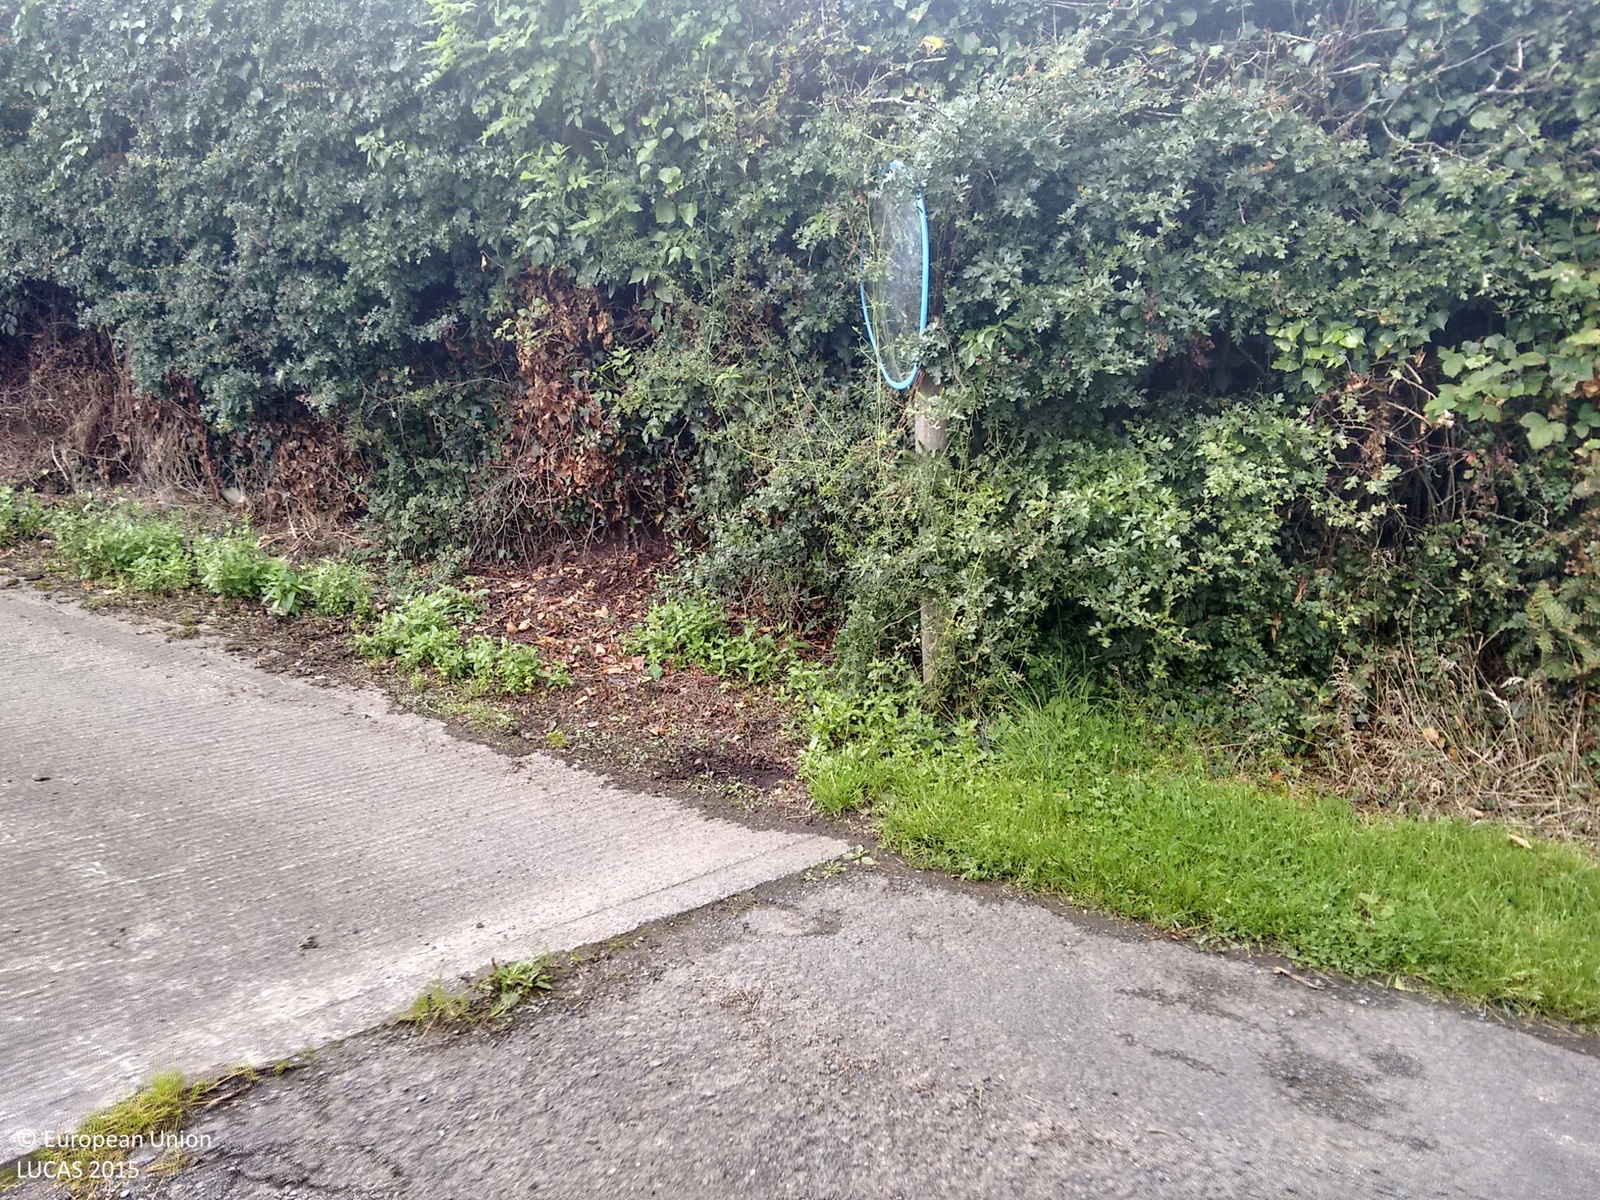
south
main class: Grassland
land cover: Grassland without tree/shrub cover
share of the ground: > 75 %
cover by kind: herbaceous plants 100 %
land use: Agriculture (excluding fallow land and kitchen gardens)
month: August
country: GB
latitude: 54.2849
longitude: -6.7370
